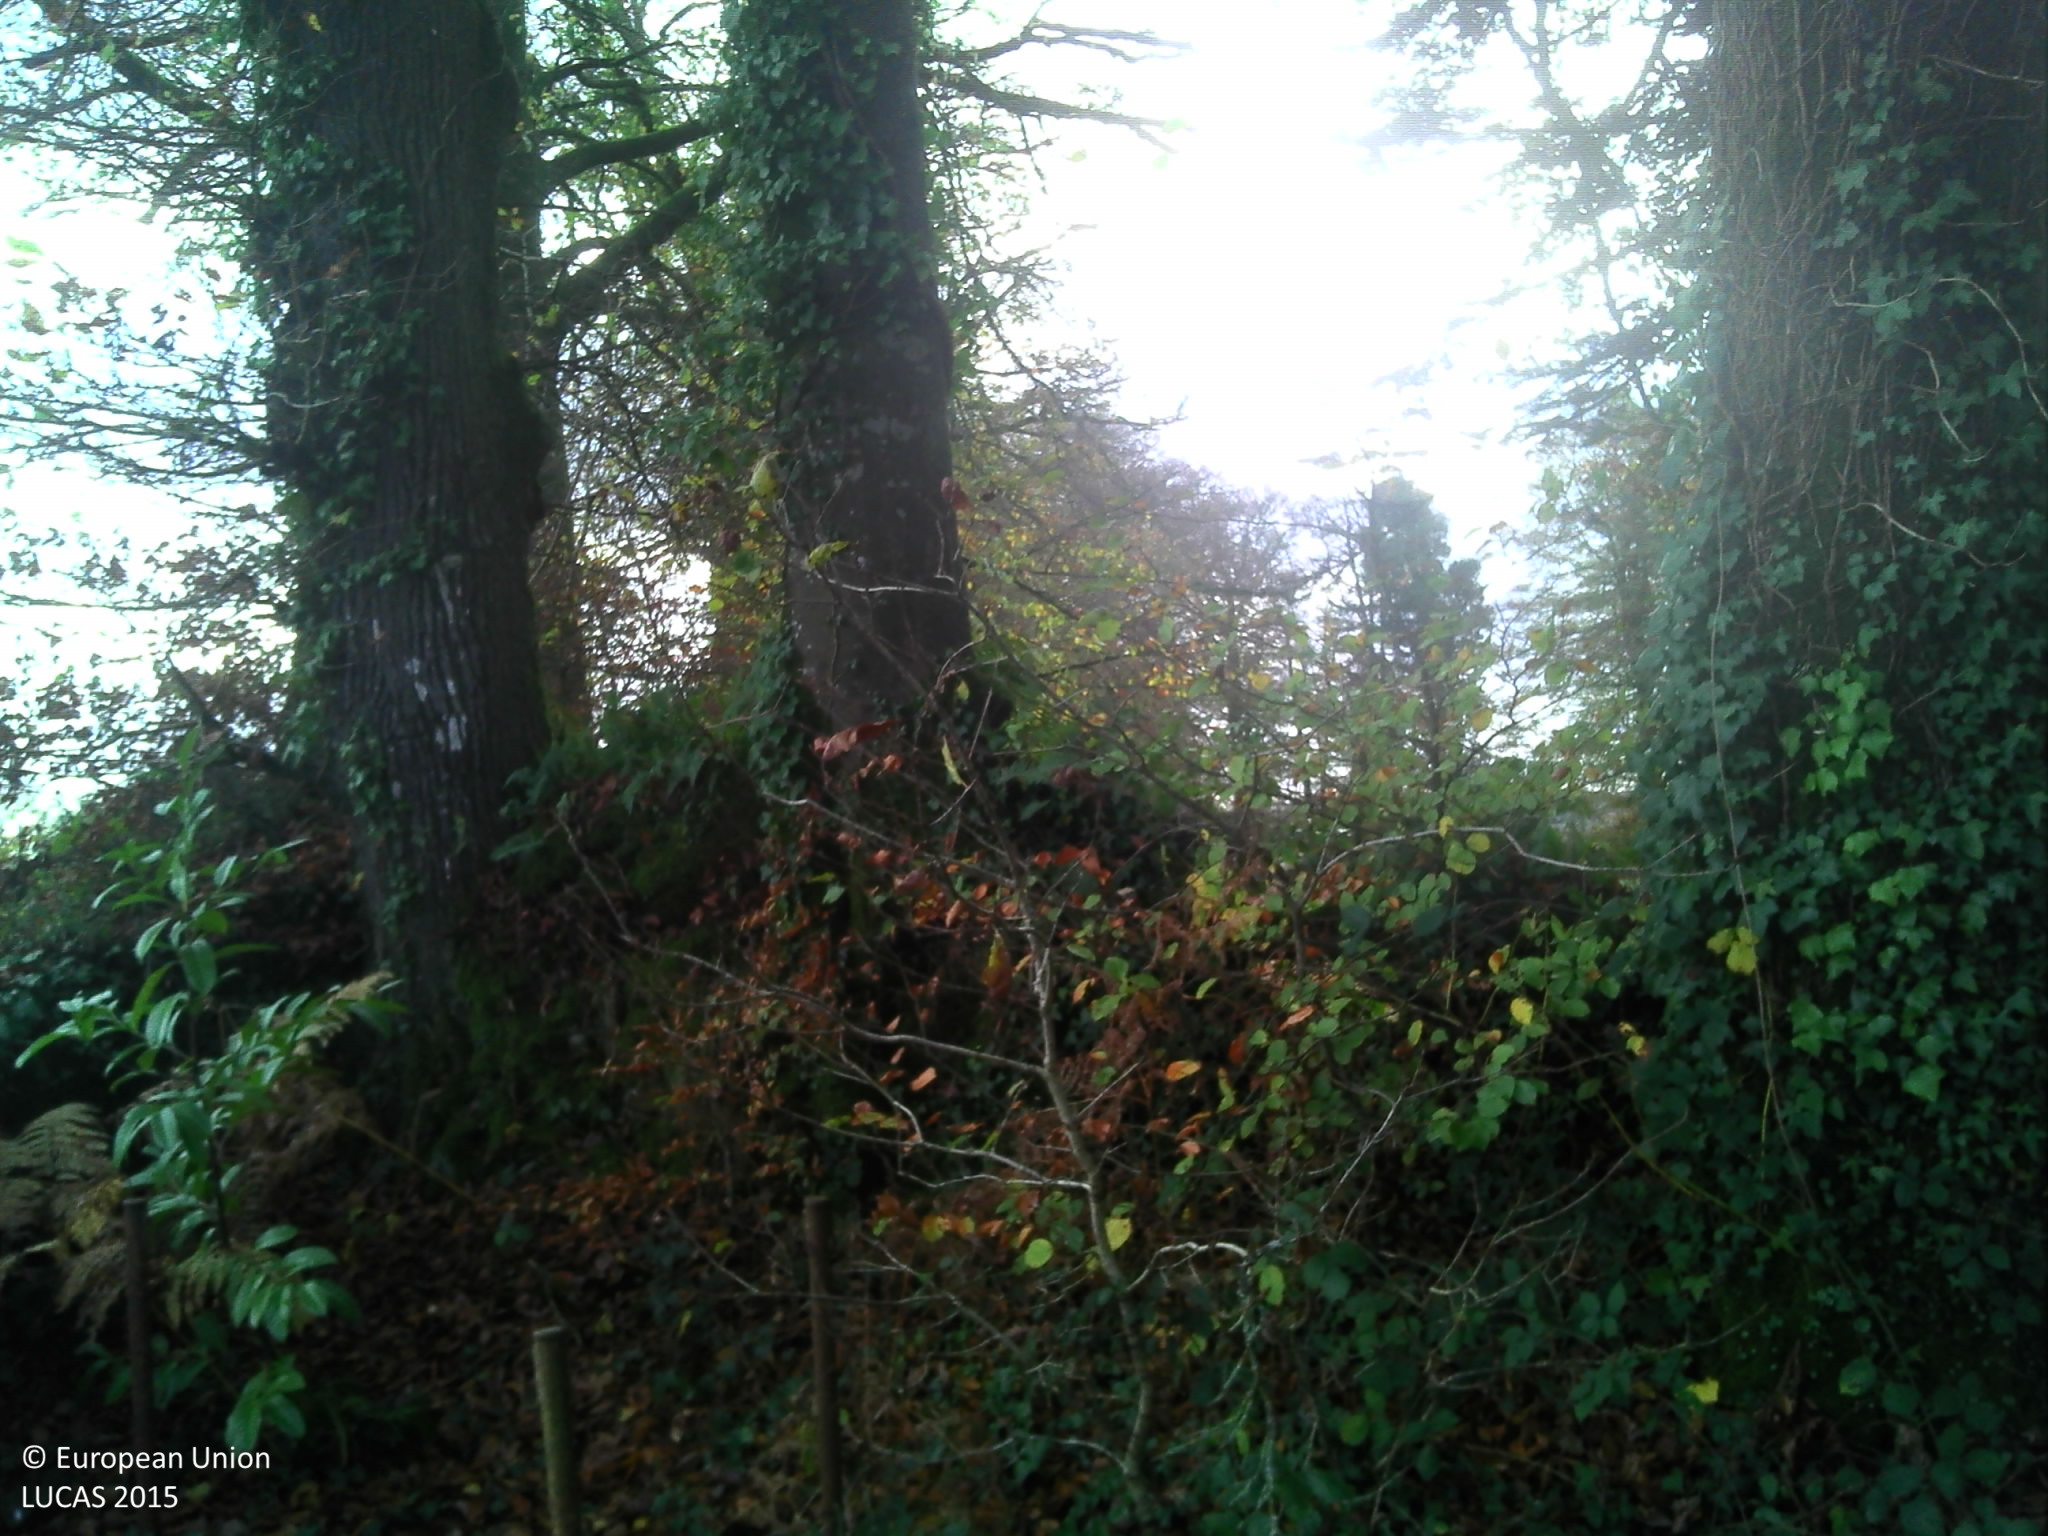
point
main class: Woodland
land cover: Broadleaved woodland
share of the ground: > 75 %
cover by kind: broadleaved forest trees 100 %
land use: Agriculture (excluding fallow land and kitchen gardens)
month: November
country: FR
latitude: 48.0658
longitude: -3.1822
